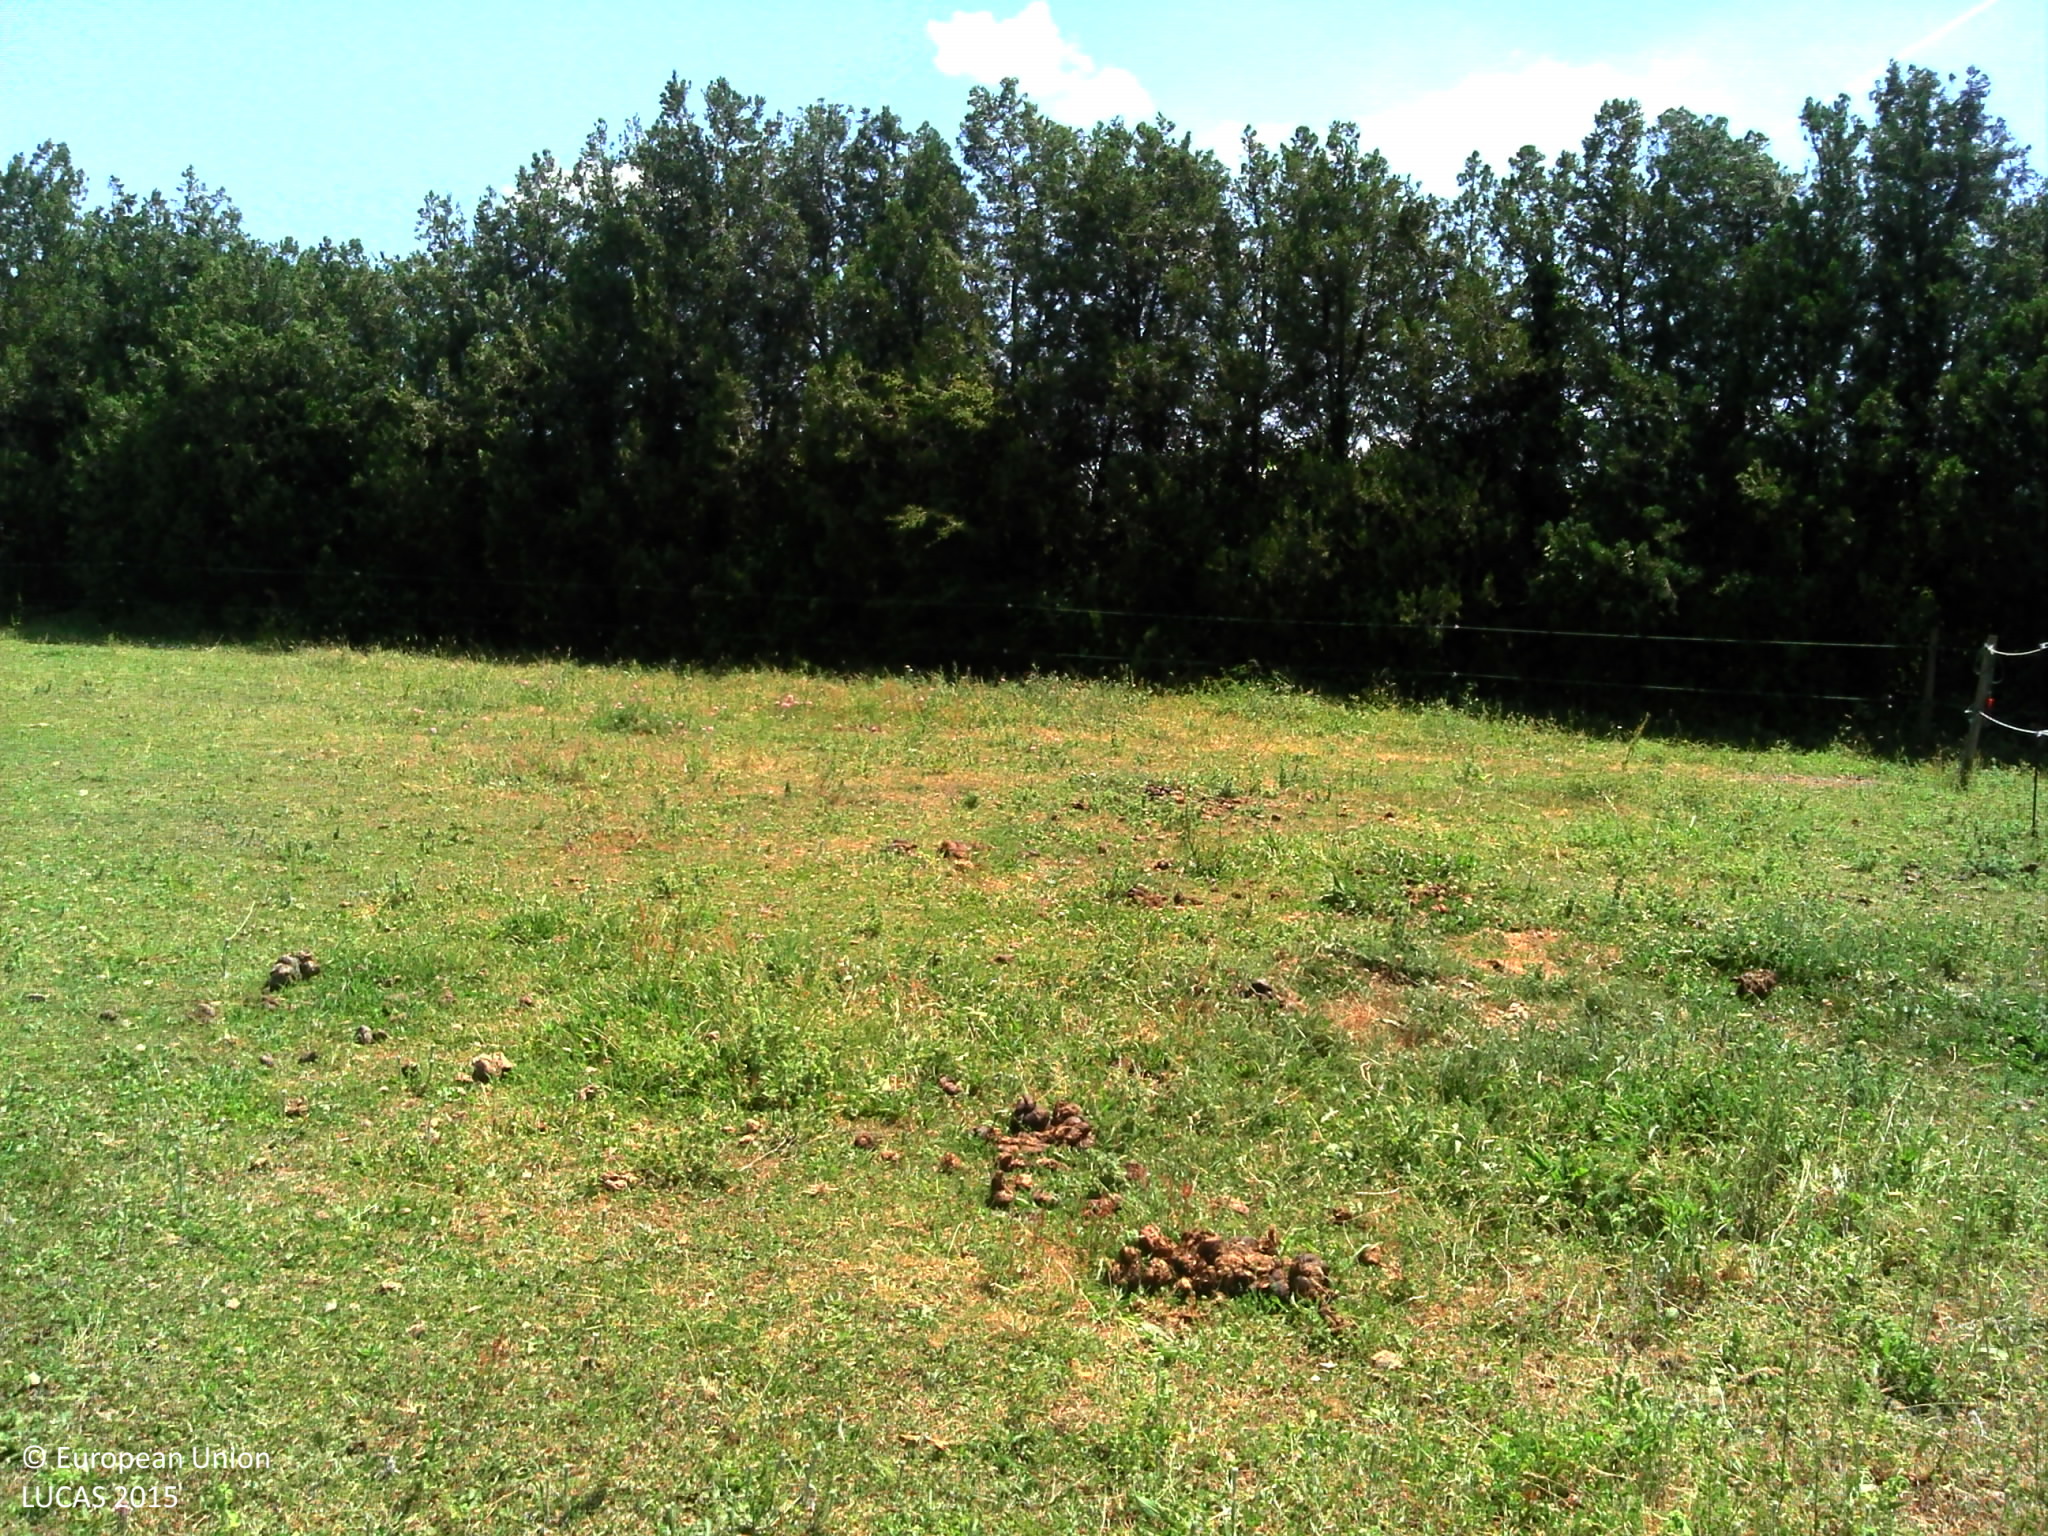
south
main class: Grassland
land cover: Grassland without tree/shrub cover
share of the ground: > 75 %
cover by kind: herbaceous plants 100 %
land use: Agriculture (excluding fallow land and kitchen gardens)
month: May
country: FR
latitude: 44.8770
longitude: 4.9297
